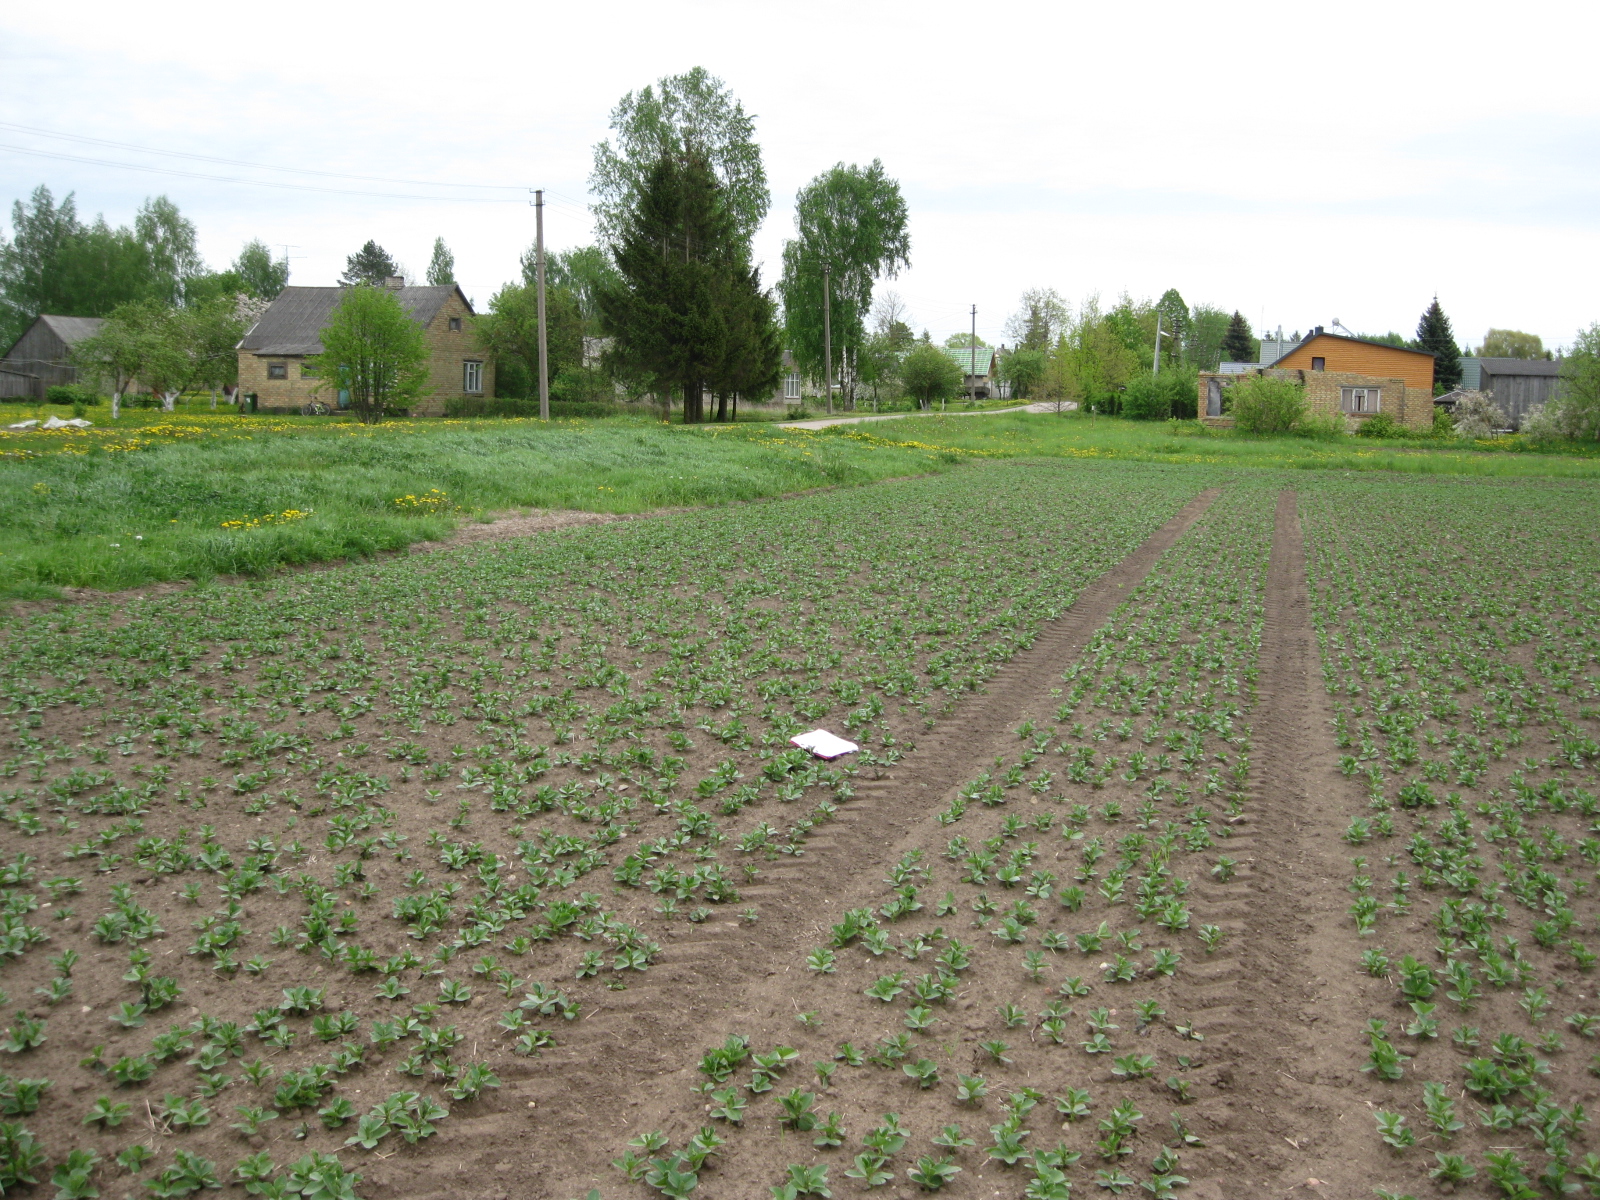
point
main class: Cropland
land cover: Dry pulses
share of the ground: 25 - 50 %
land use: Agriculture (excluding fallow land and kitchen gardens)
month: May
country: LT
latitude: 56.2034
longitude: 23.4712
